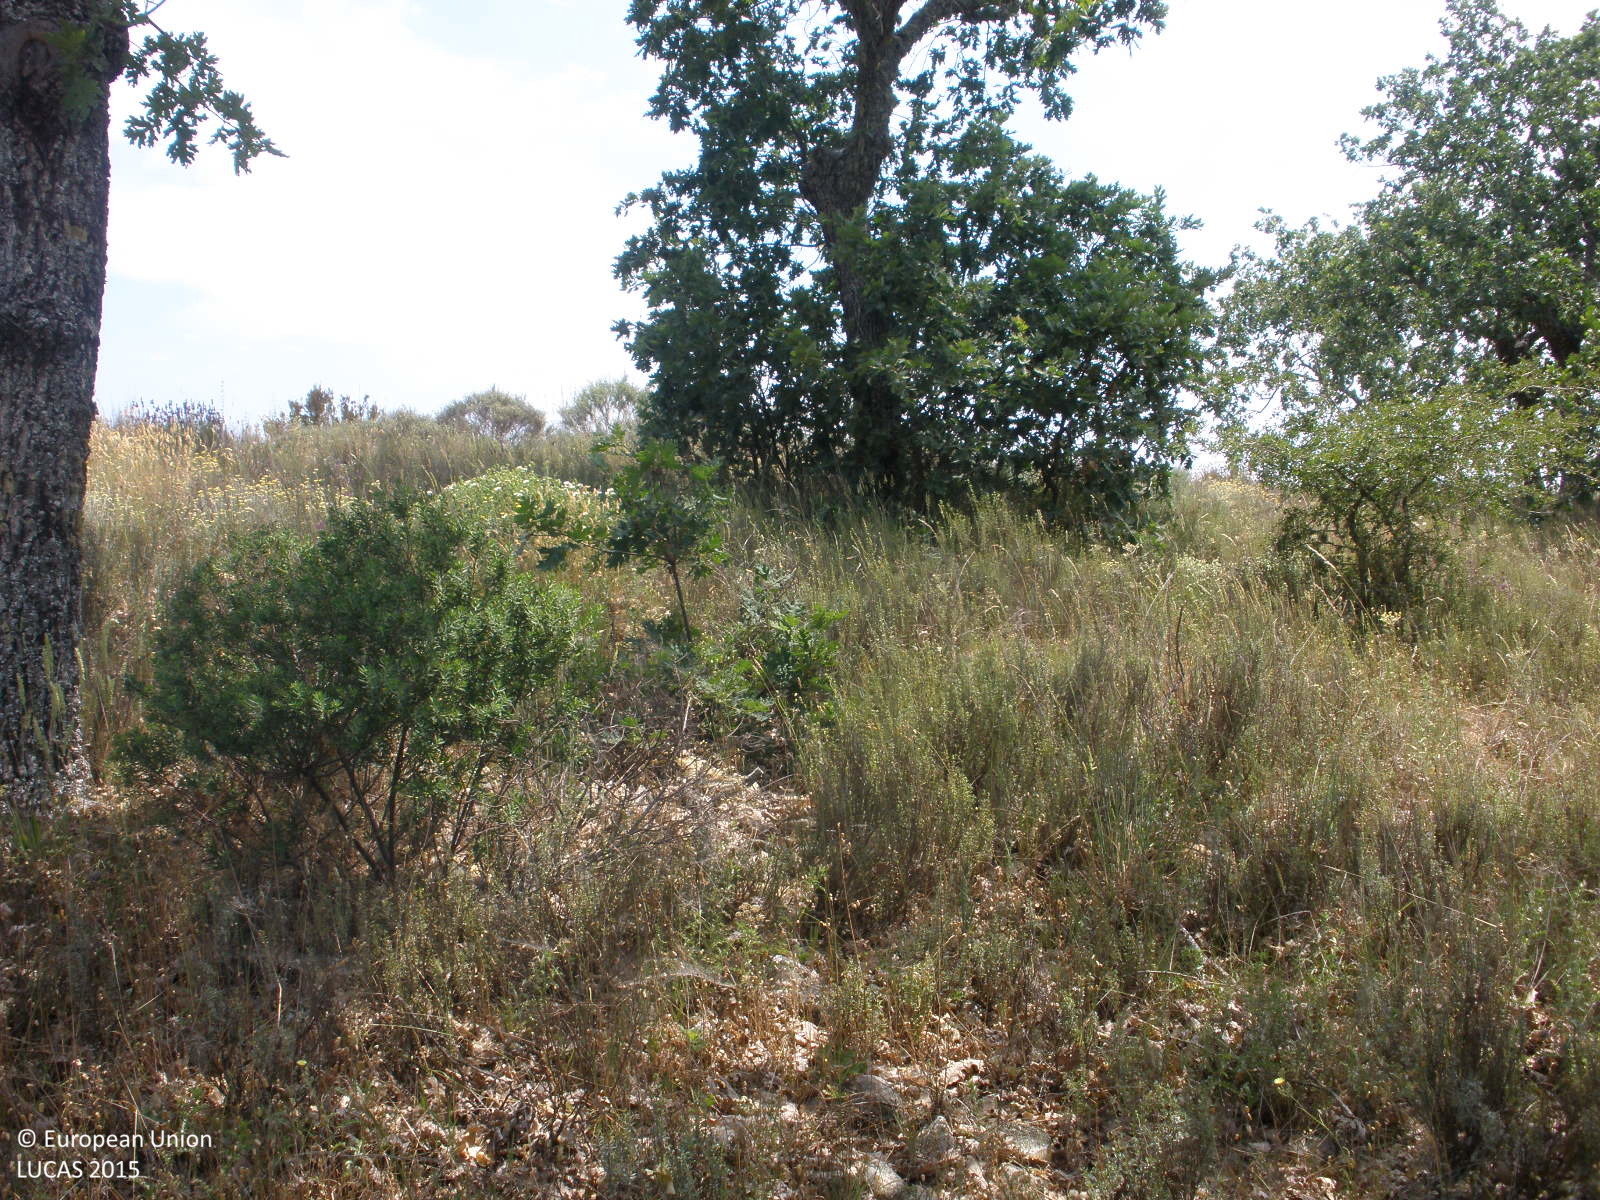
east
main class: Woodland
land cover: Broadleaved woodland
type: thermophilous deciduous forest
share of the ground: > 75 %
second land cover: Grassland without tree/shrub cover
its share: > 75 %
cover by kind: broadleaved forest trees 60 %, herbaceous plants 30 %, shrubs 10 %
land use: Forestry
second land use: Agriculture (excluding fallow land and kitchen gardens)
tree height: > 5 m
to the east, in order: Broadleaved woodland; Grassland without tree/shrub cover; Tracks; Grass margins; Fences; Broadleaved woodland; Fences; Grassland without tree/shrub cover
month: June
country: ES
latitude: 40.5863
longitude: -6.3066
